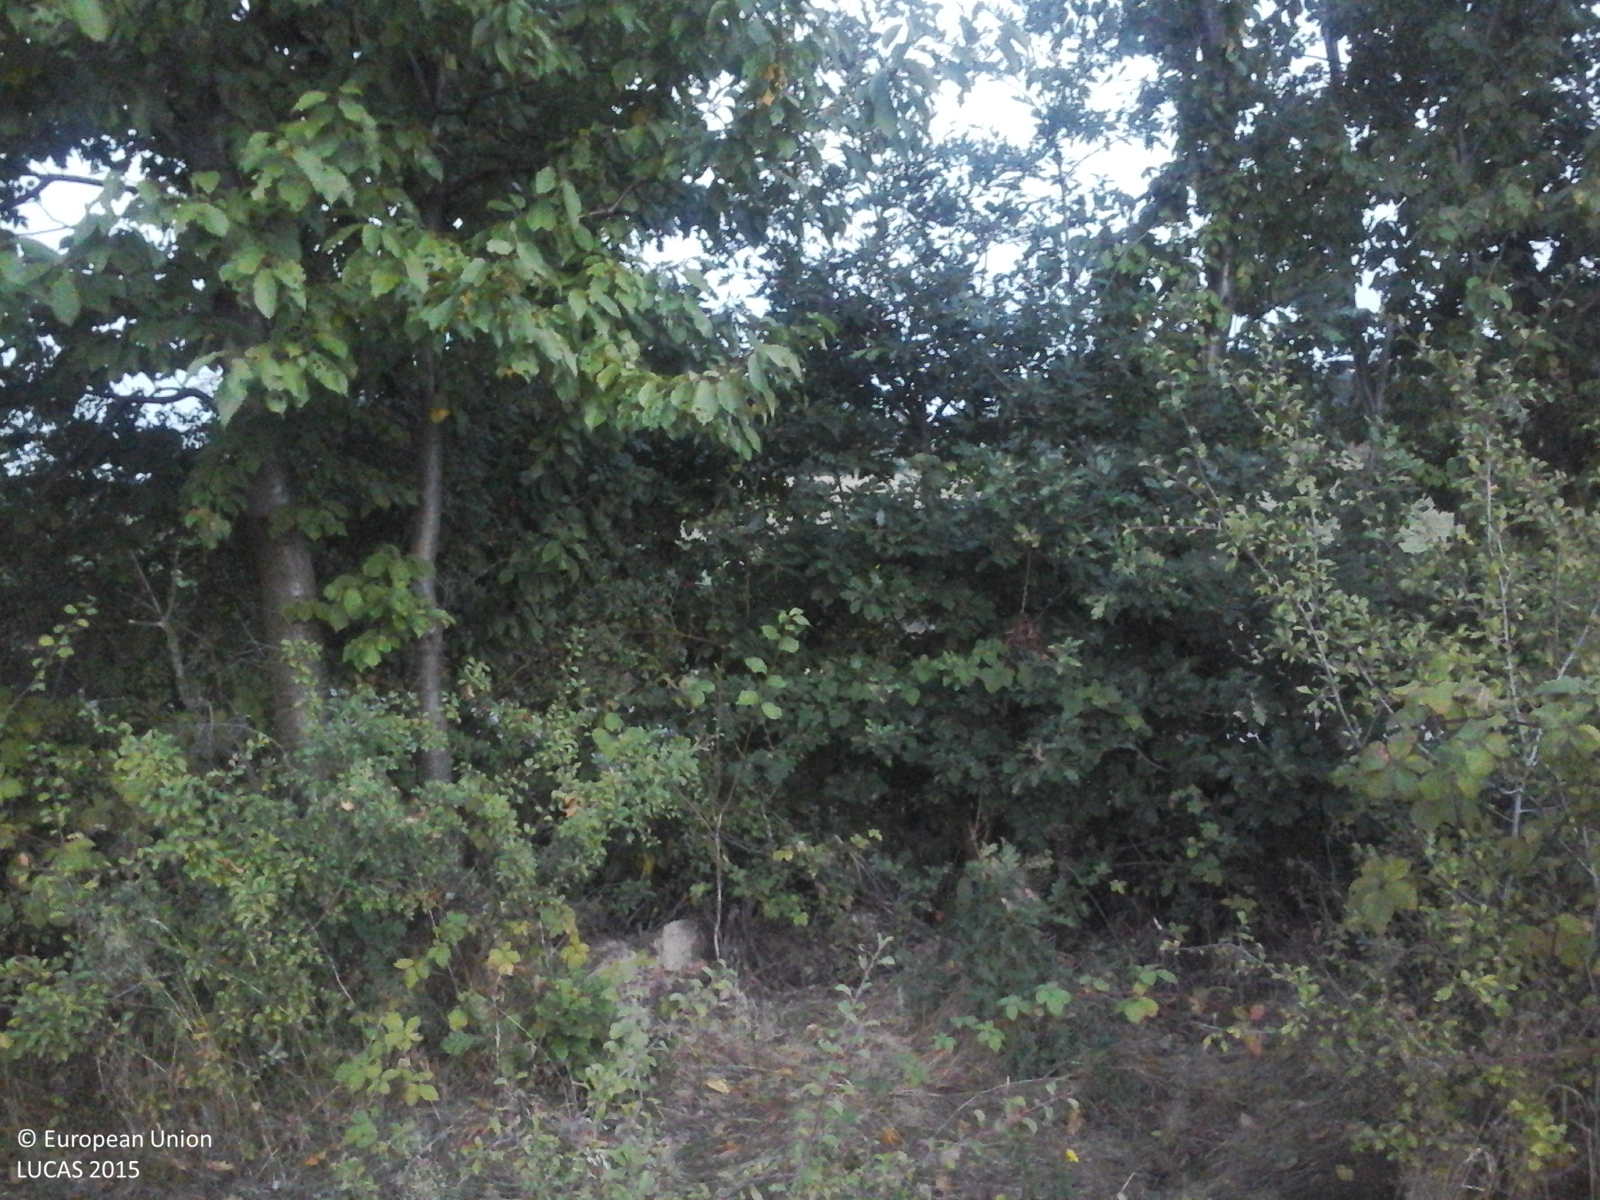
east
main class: Grassland
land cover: Spontaneously vegetated surfaces
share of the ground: > 75 %
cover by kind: herbaceous plants 100 %
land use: Agriculture (excluding fallow land and kitchen gardens)
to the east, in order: Spontaneously vegetated surfaces; Lines of trees; Tracks; Ditches and canals; Grassland without tree/shrub cover; Abandoned hedges; Grassland without tree/shrub cover
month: September
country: RO
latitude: 47.1305
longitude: 22.6205
